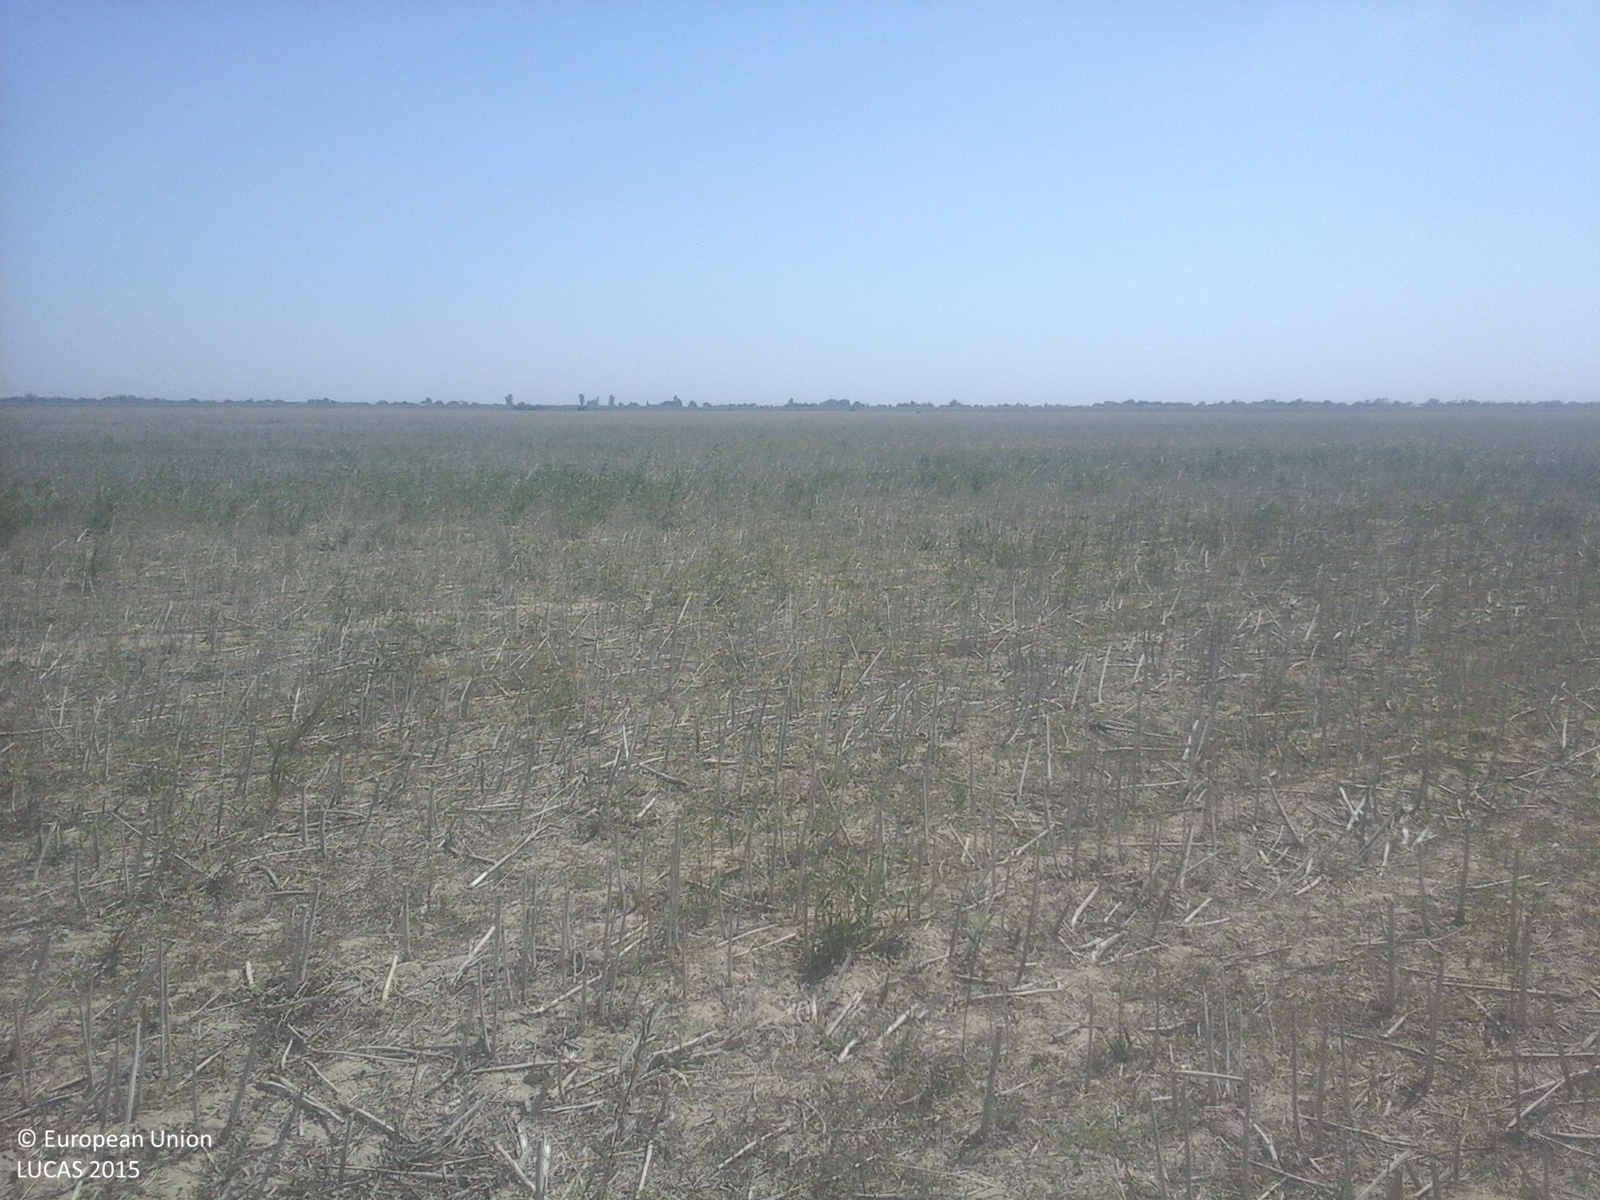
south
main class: Cropland
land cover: Rape and turnip rape
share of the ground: 25 - 50 %
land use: Agriculture (excluding fallow land and kitchen gardens)
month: August
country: RO
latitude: 45.5325
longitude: 27.4256
